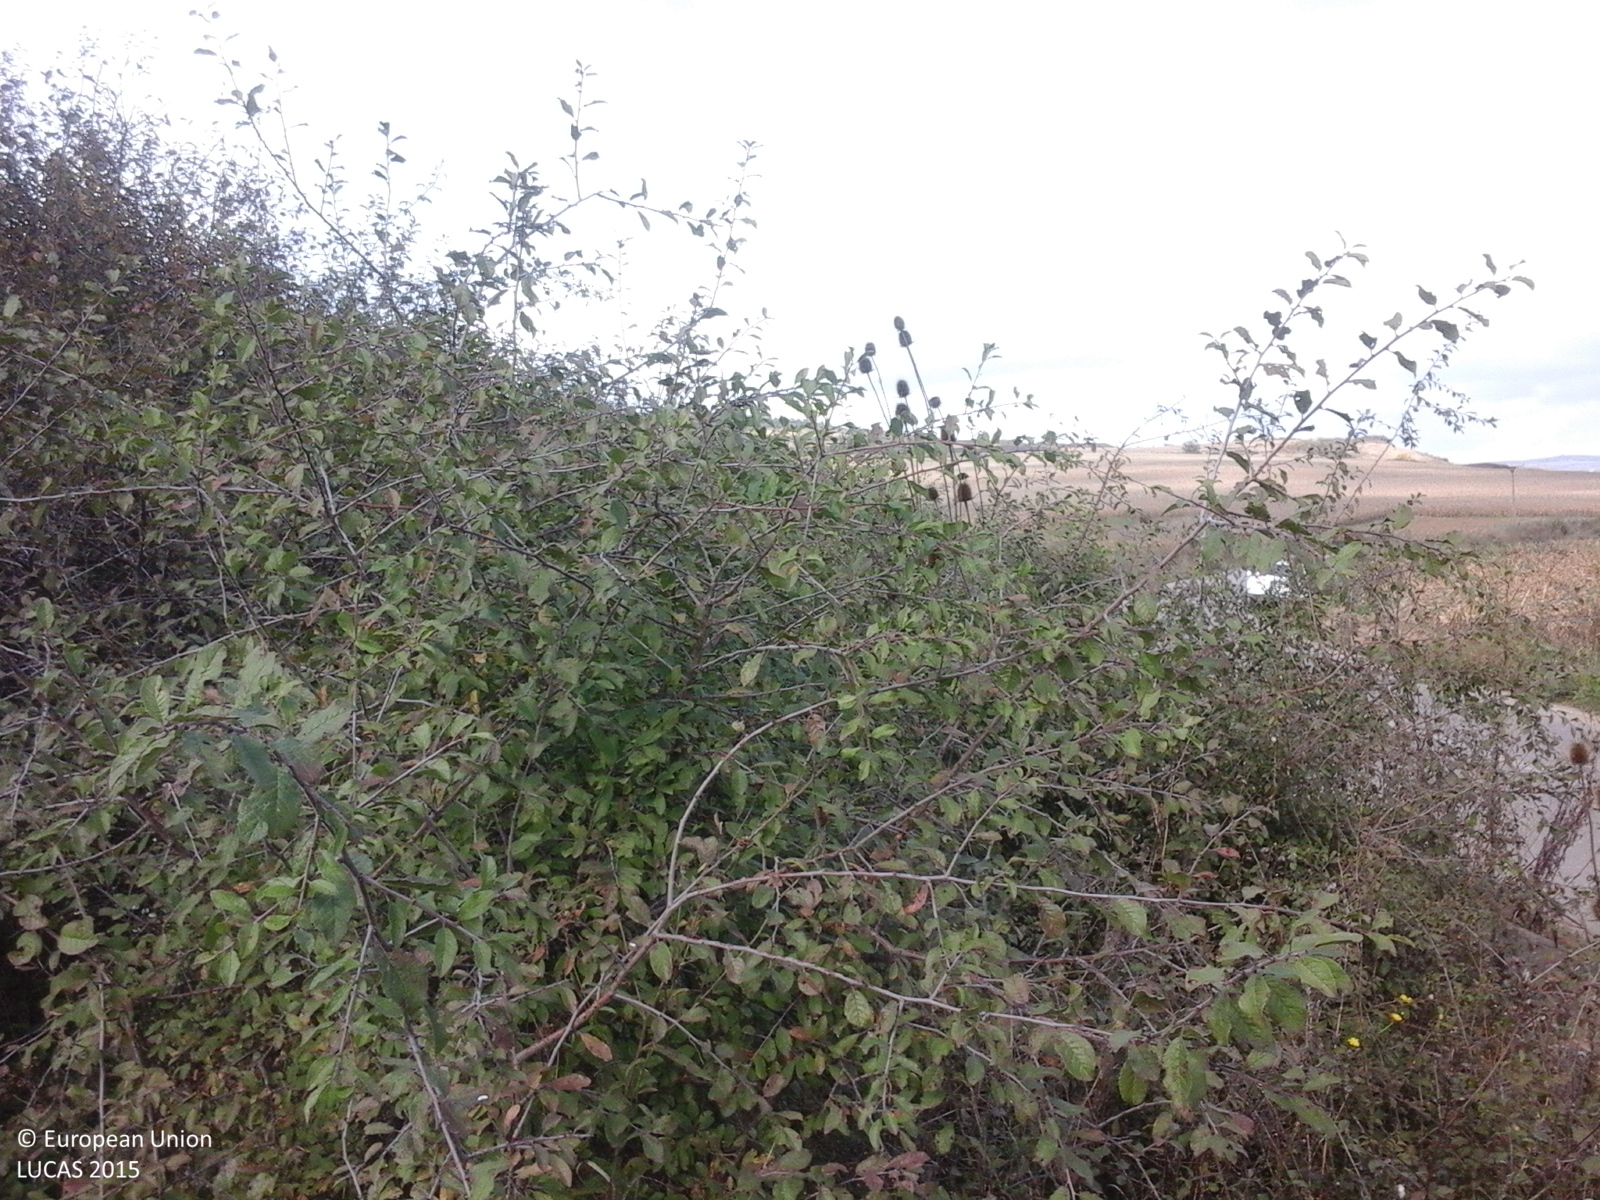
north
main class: Cropland
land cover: Maize
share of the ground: > 75 %
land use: Agriculture (excluding fallow land and kitchen gardens)
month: October
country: RO
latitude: 46.2487
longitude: 24.1248
